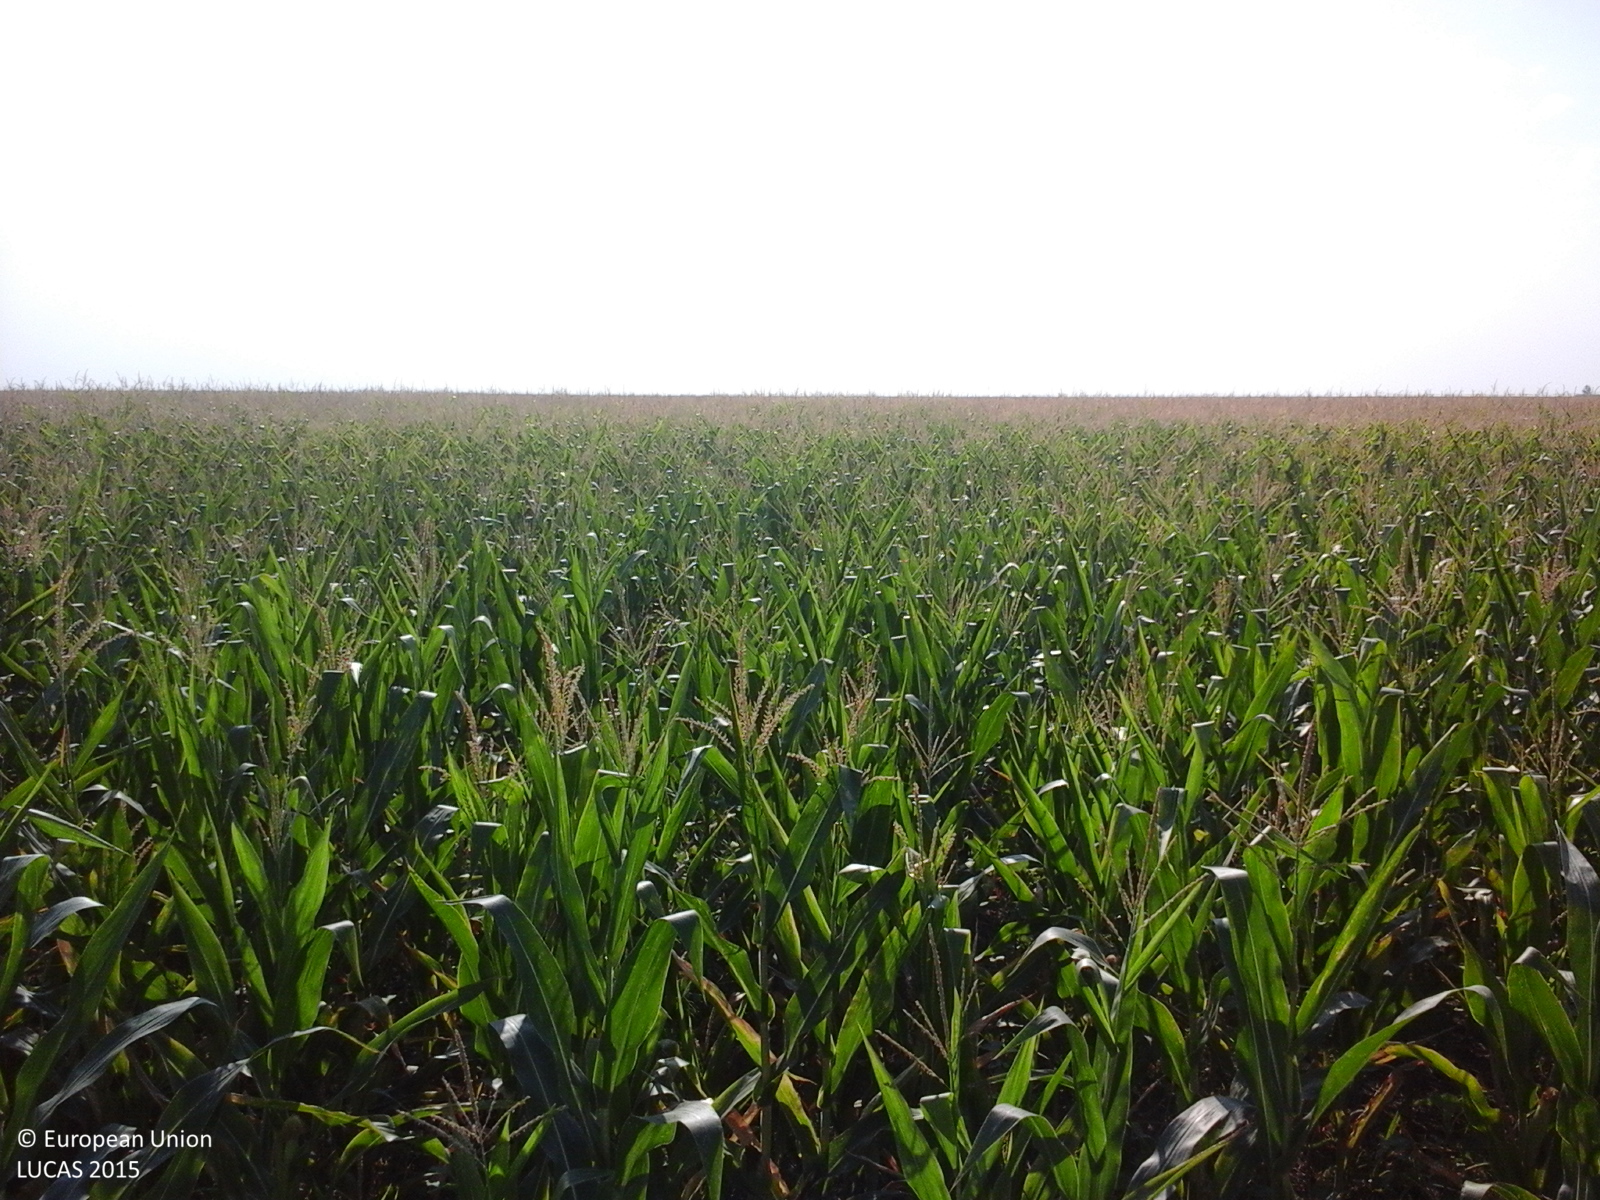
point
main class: Cropland
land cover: Maize
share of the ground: > 75 %
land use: Agriculture (excluding fallow land and kitchen gardens)
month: August
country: RO
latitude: 43.9846
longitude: 23.7044
